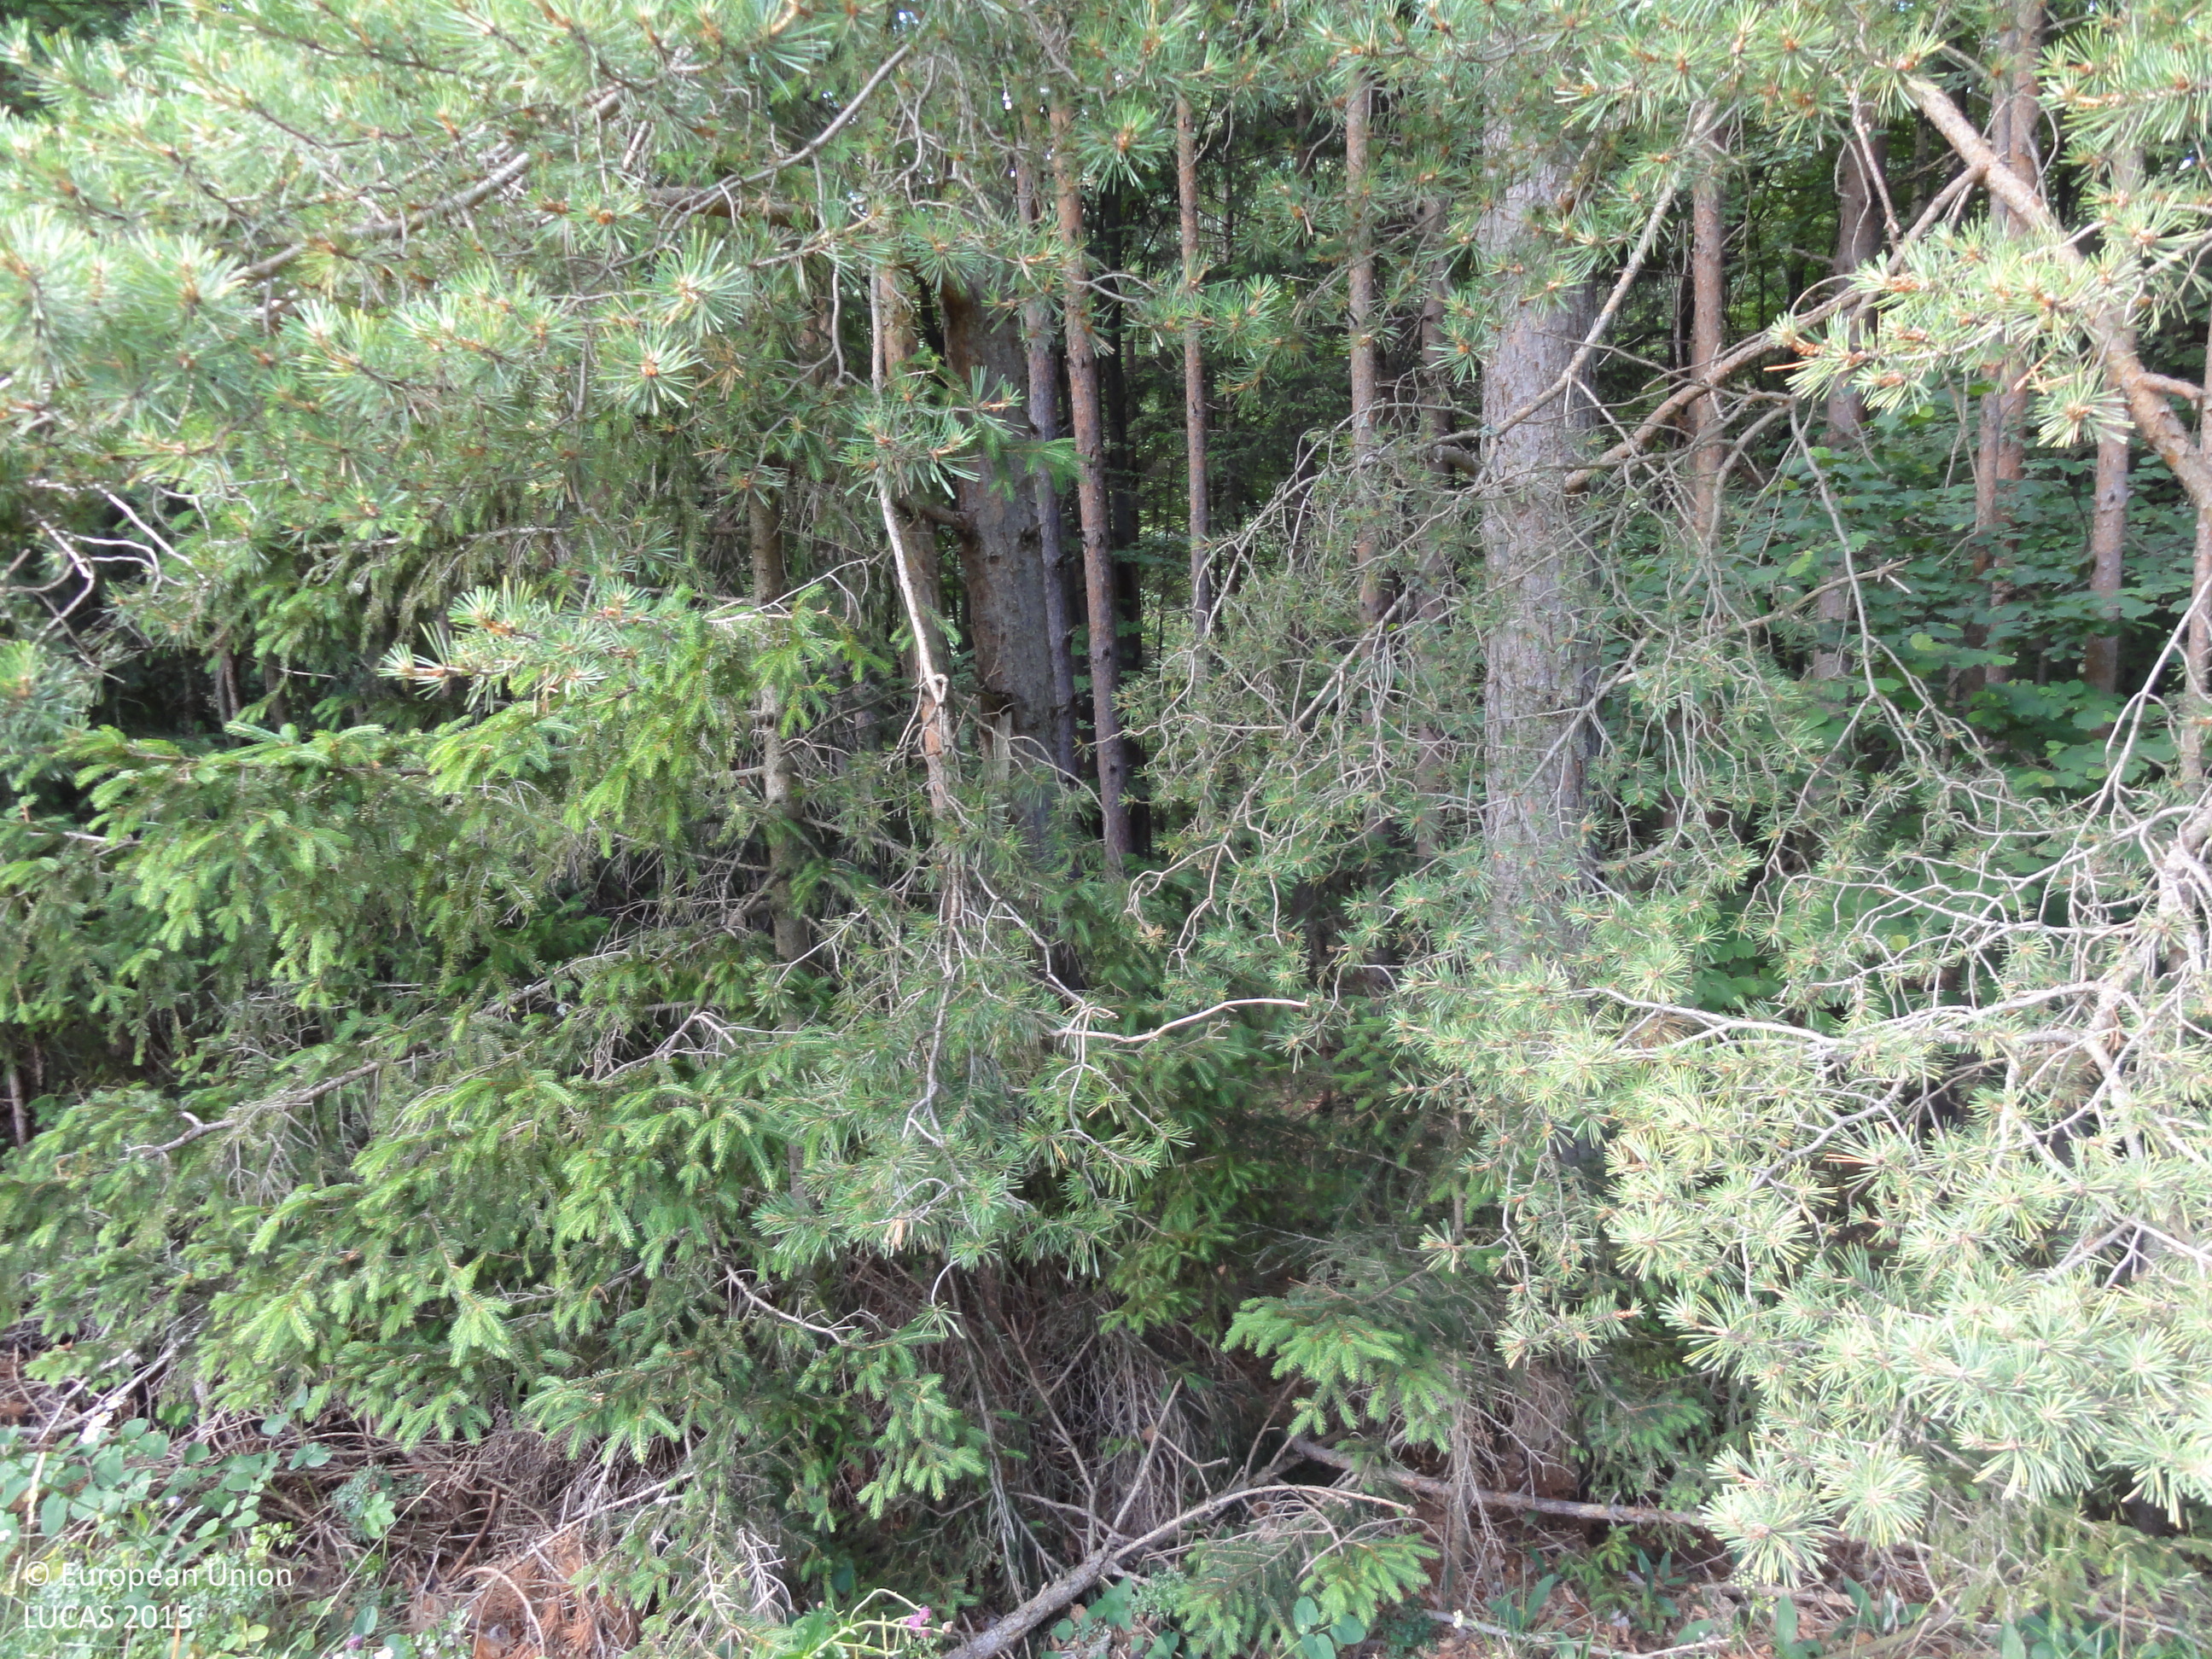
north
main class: Grassland
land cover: Grassland without tree/shrub cover
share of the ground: > 75 %
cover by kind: herbaceous plants 100 %
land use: Agriculture (excluding fallow land and kitchen gardens)
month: June
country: SI
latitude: 46.3661
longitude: 15.2623
